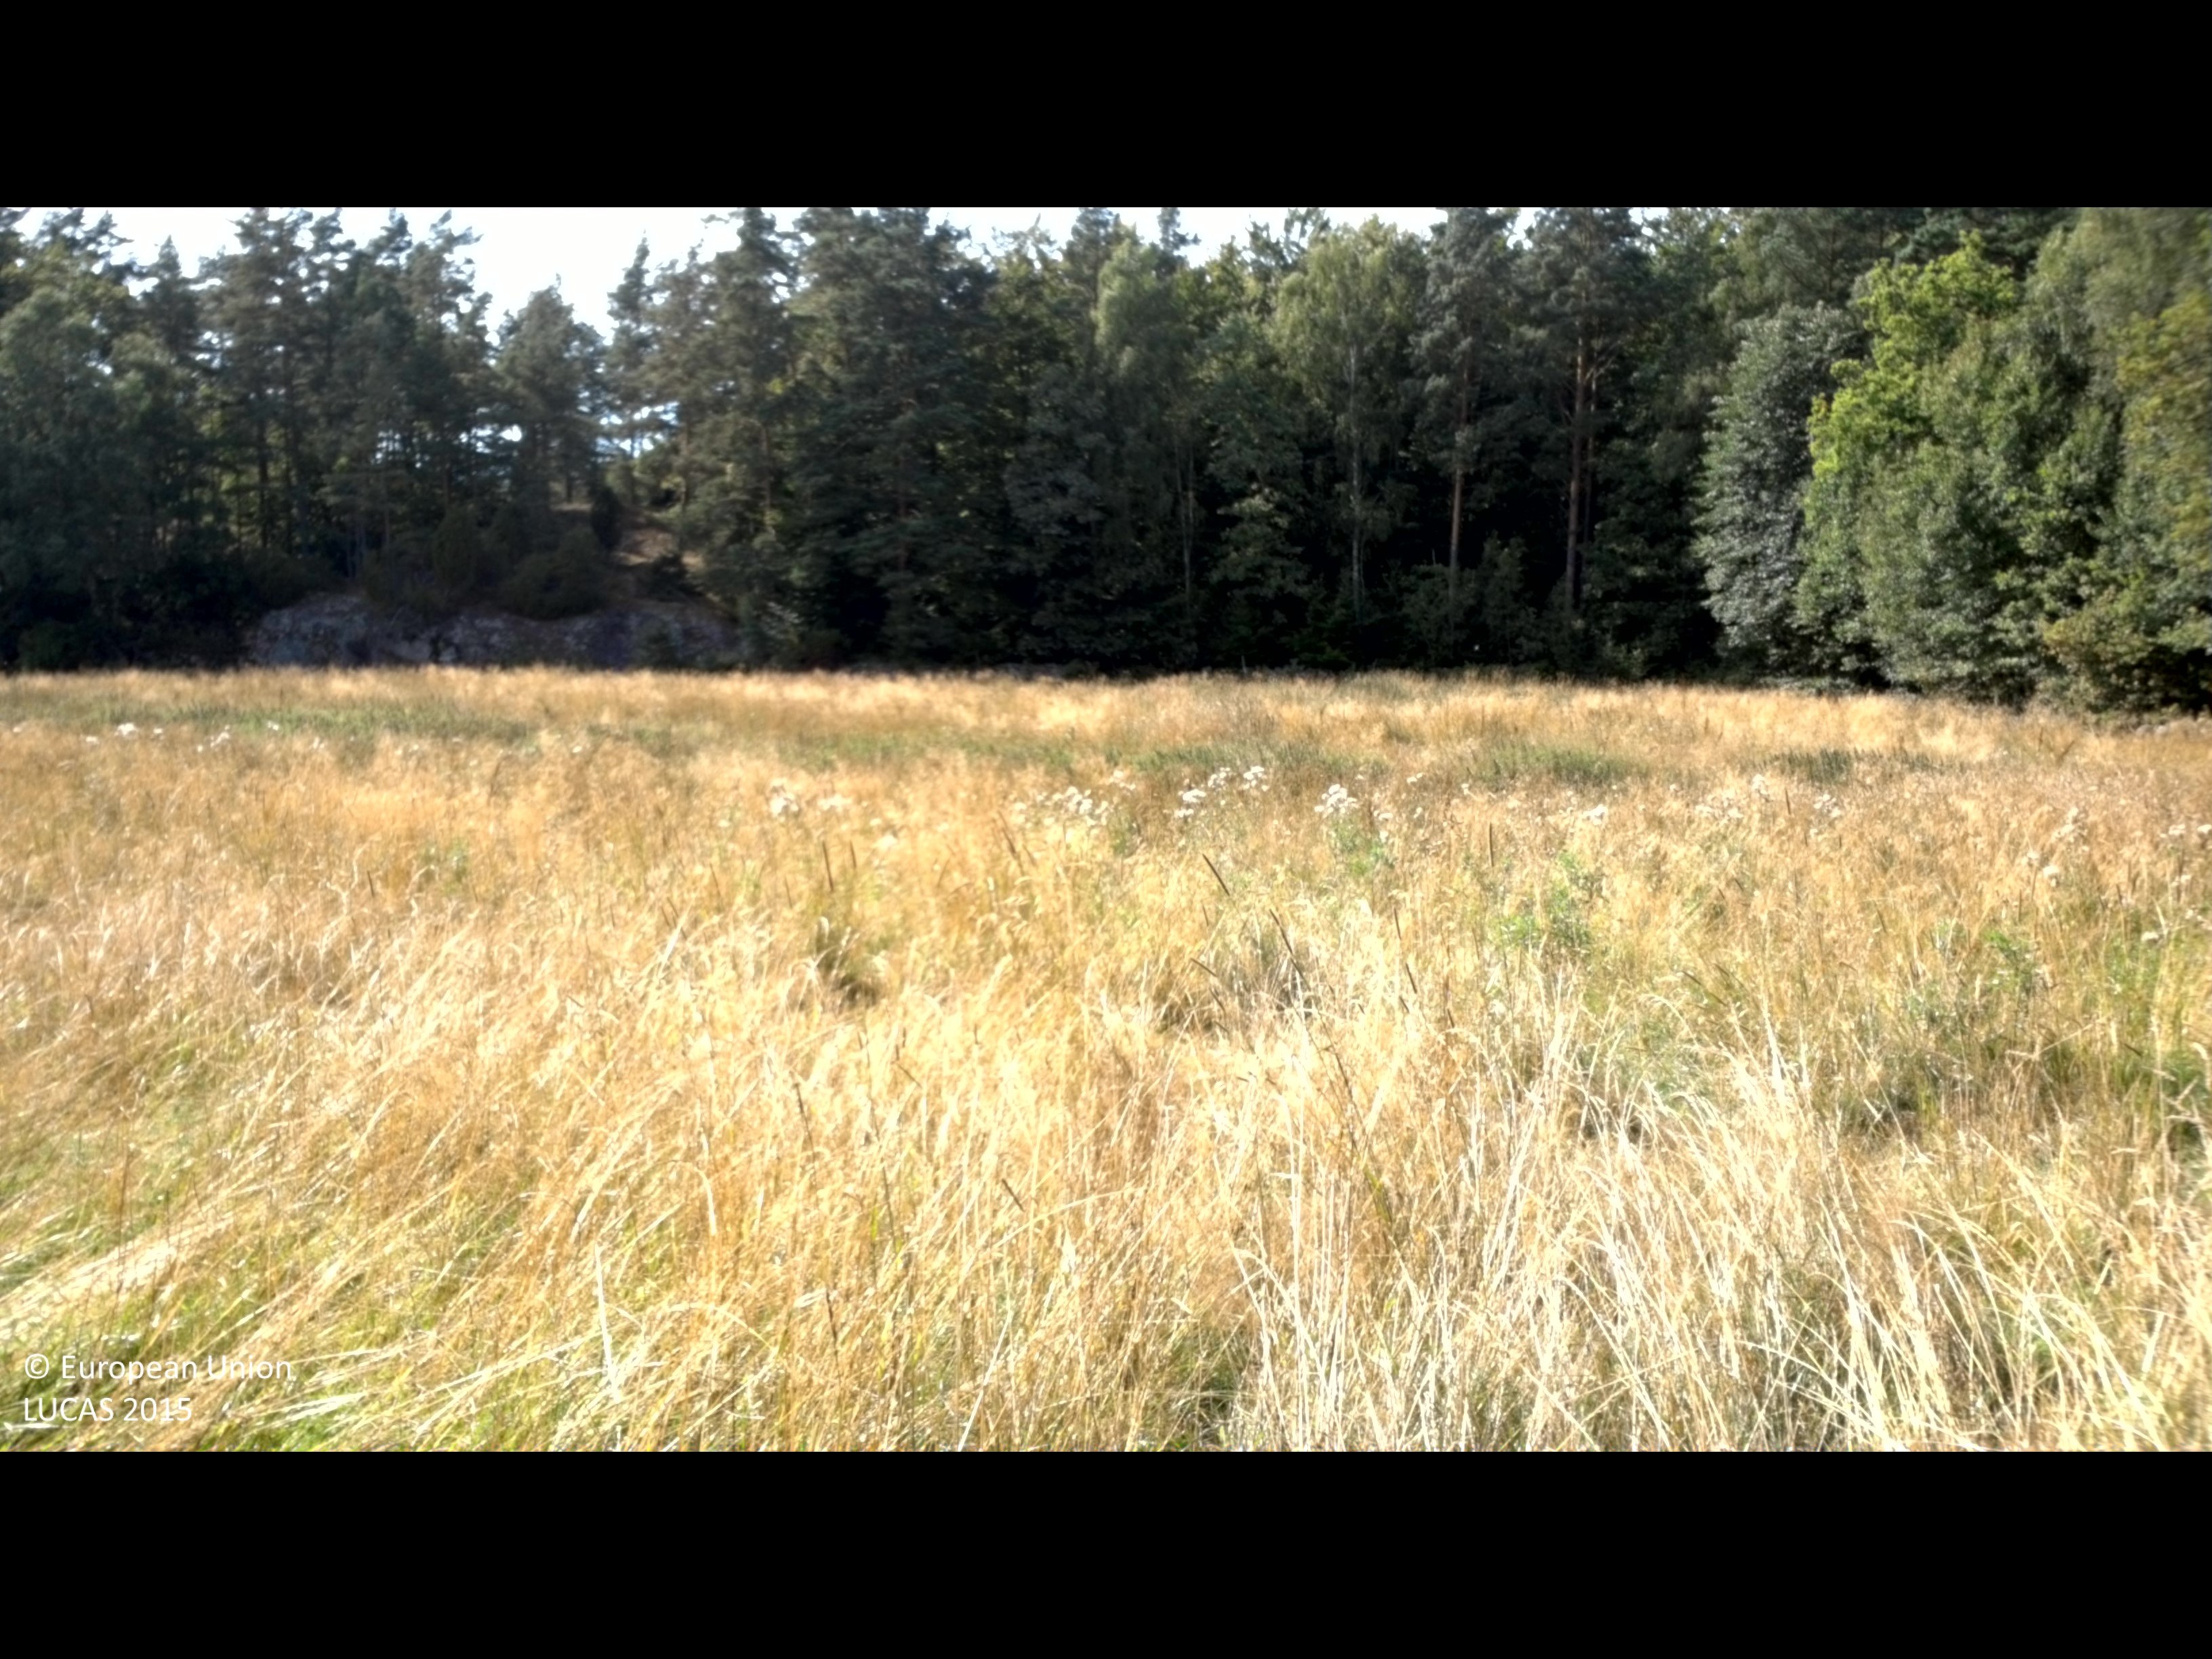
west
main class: Grassland
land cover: Grassland without tree/shrub cover
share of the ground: > 75 %
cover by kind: herbaceous plants 100 %
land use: Agriculture (excluding fallow land and kitchen gardens)
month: August
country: SE
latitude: 56.1887
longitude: 14.7841
